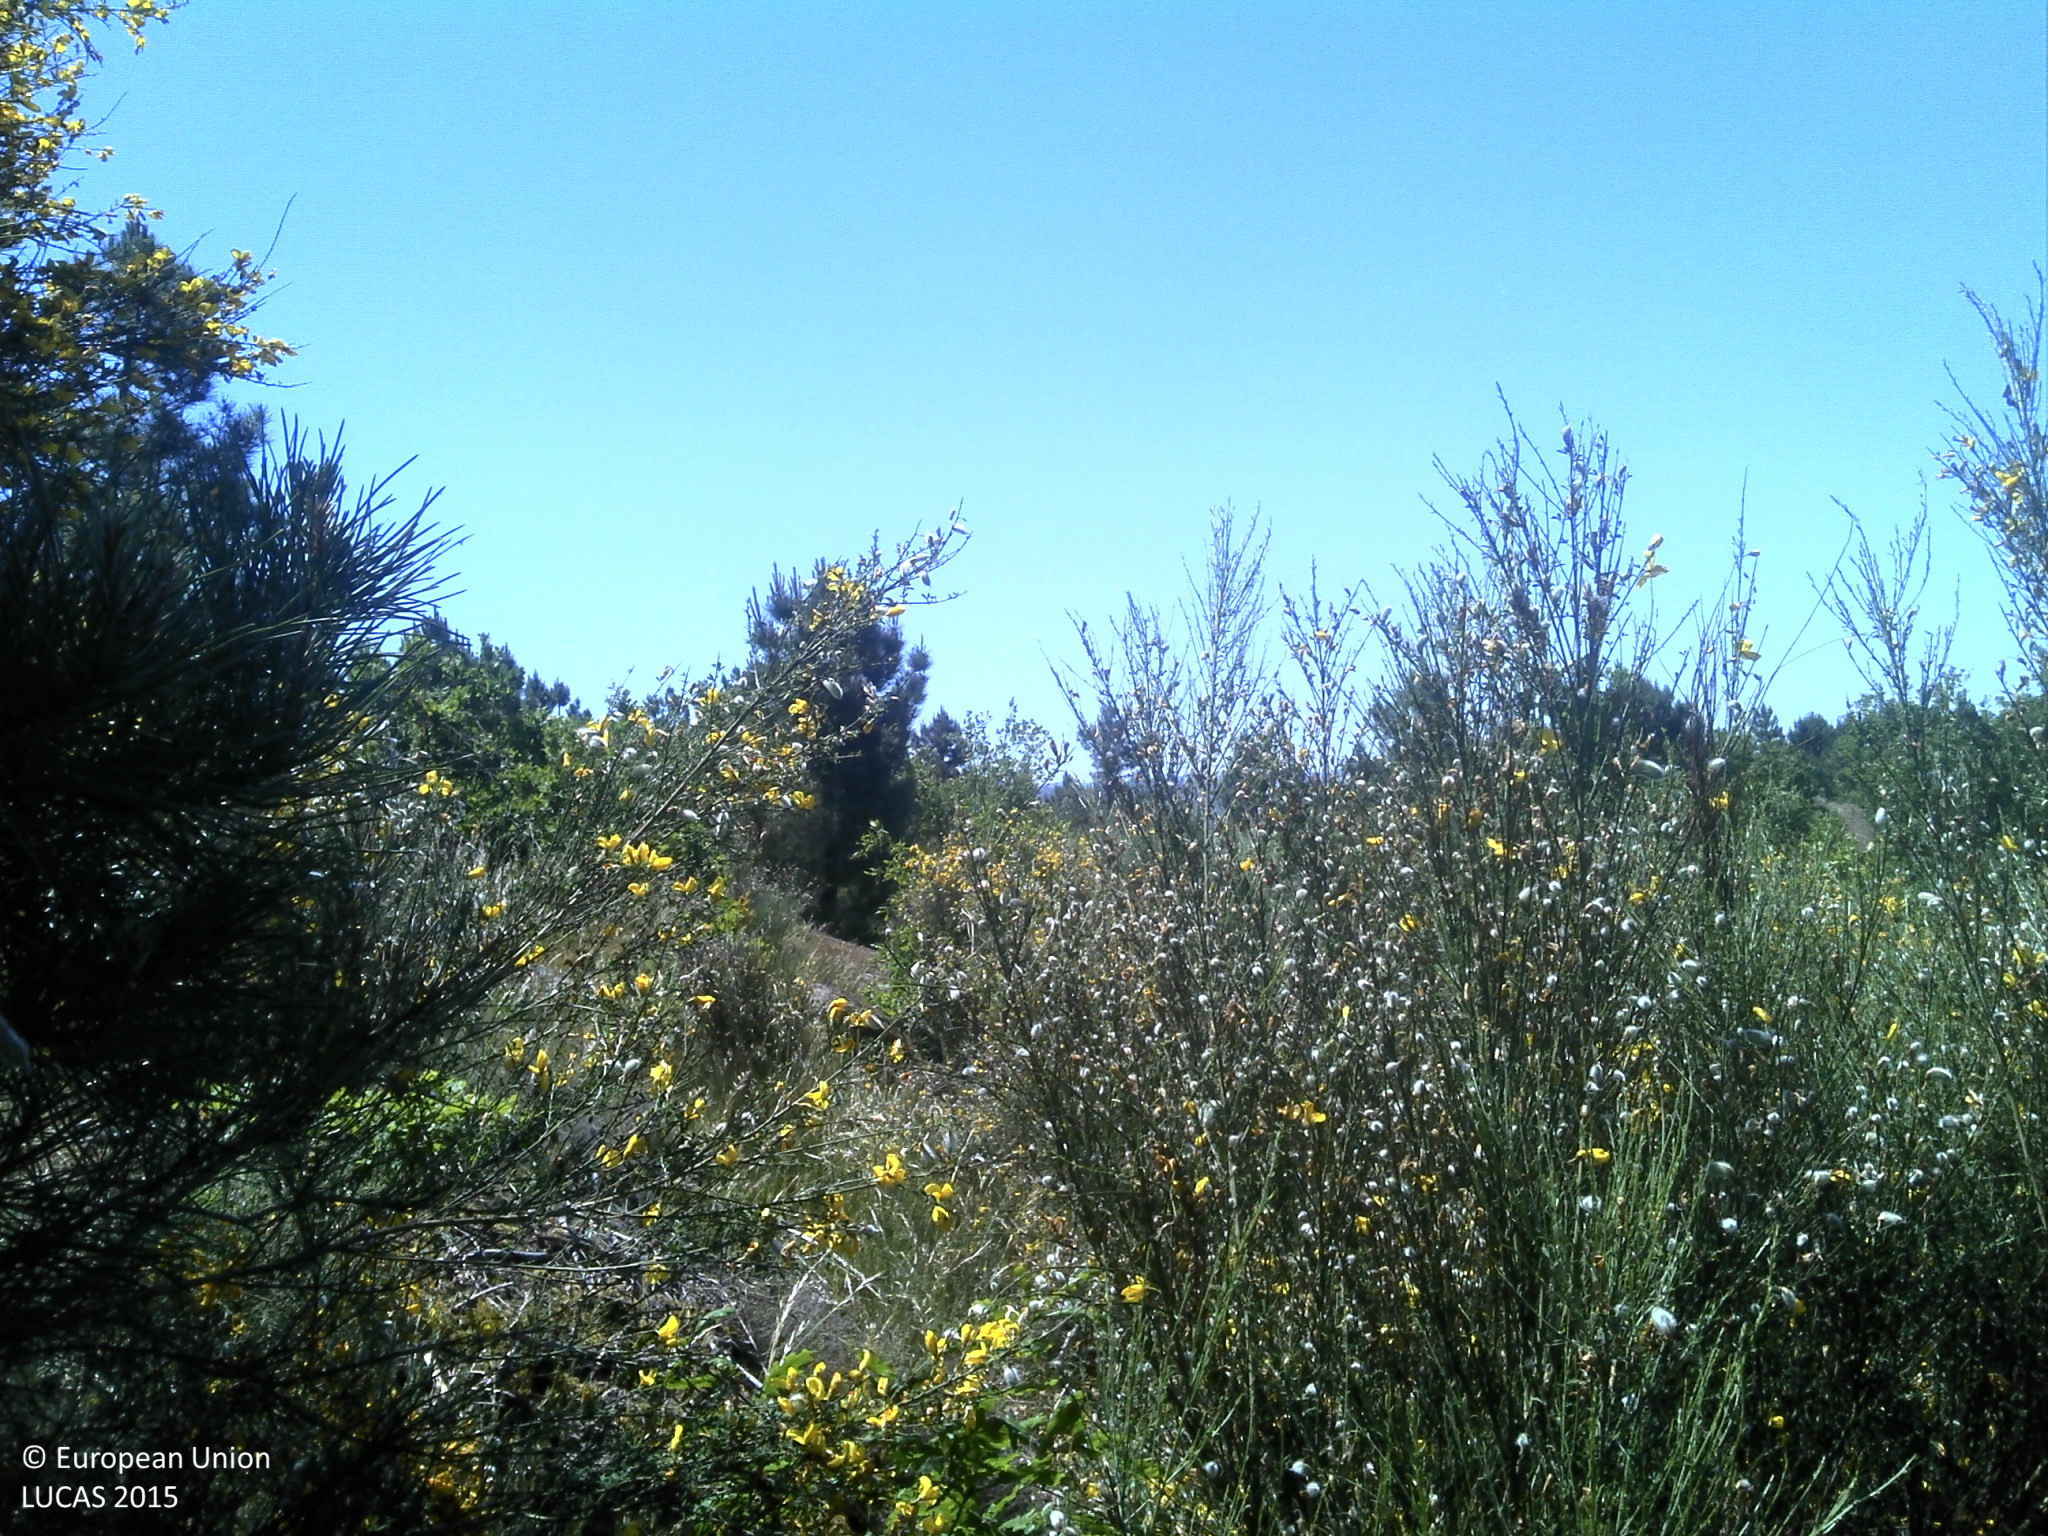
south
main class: Woodland
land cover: Pine dominated coniferous woodland
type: coniferous forest of the mediterranean region
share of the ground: 10 - 25 %
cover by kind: shrubs 60 %, coniferous forest trees 25 %, unconsolidated bare surface 15 %
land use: Forestry
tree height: > 5 m
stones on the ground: 10 - 25 %
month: May
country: PT
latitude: 40.3968
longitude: -7.7046
